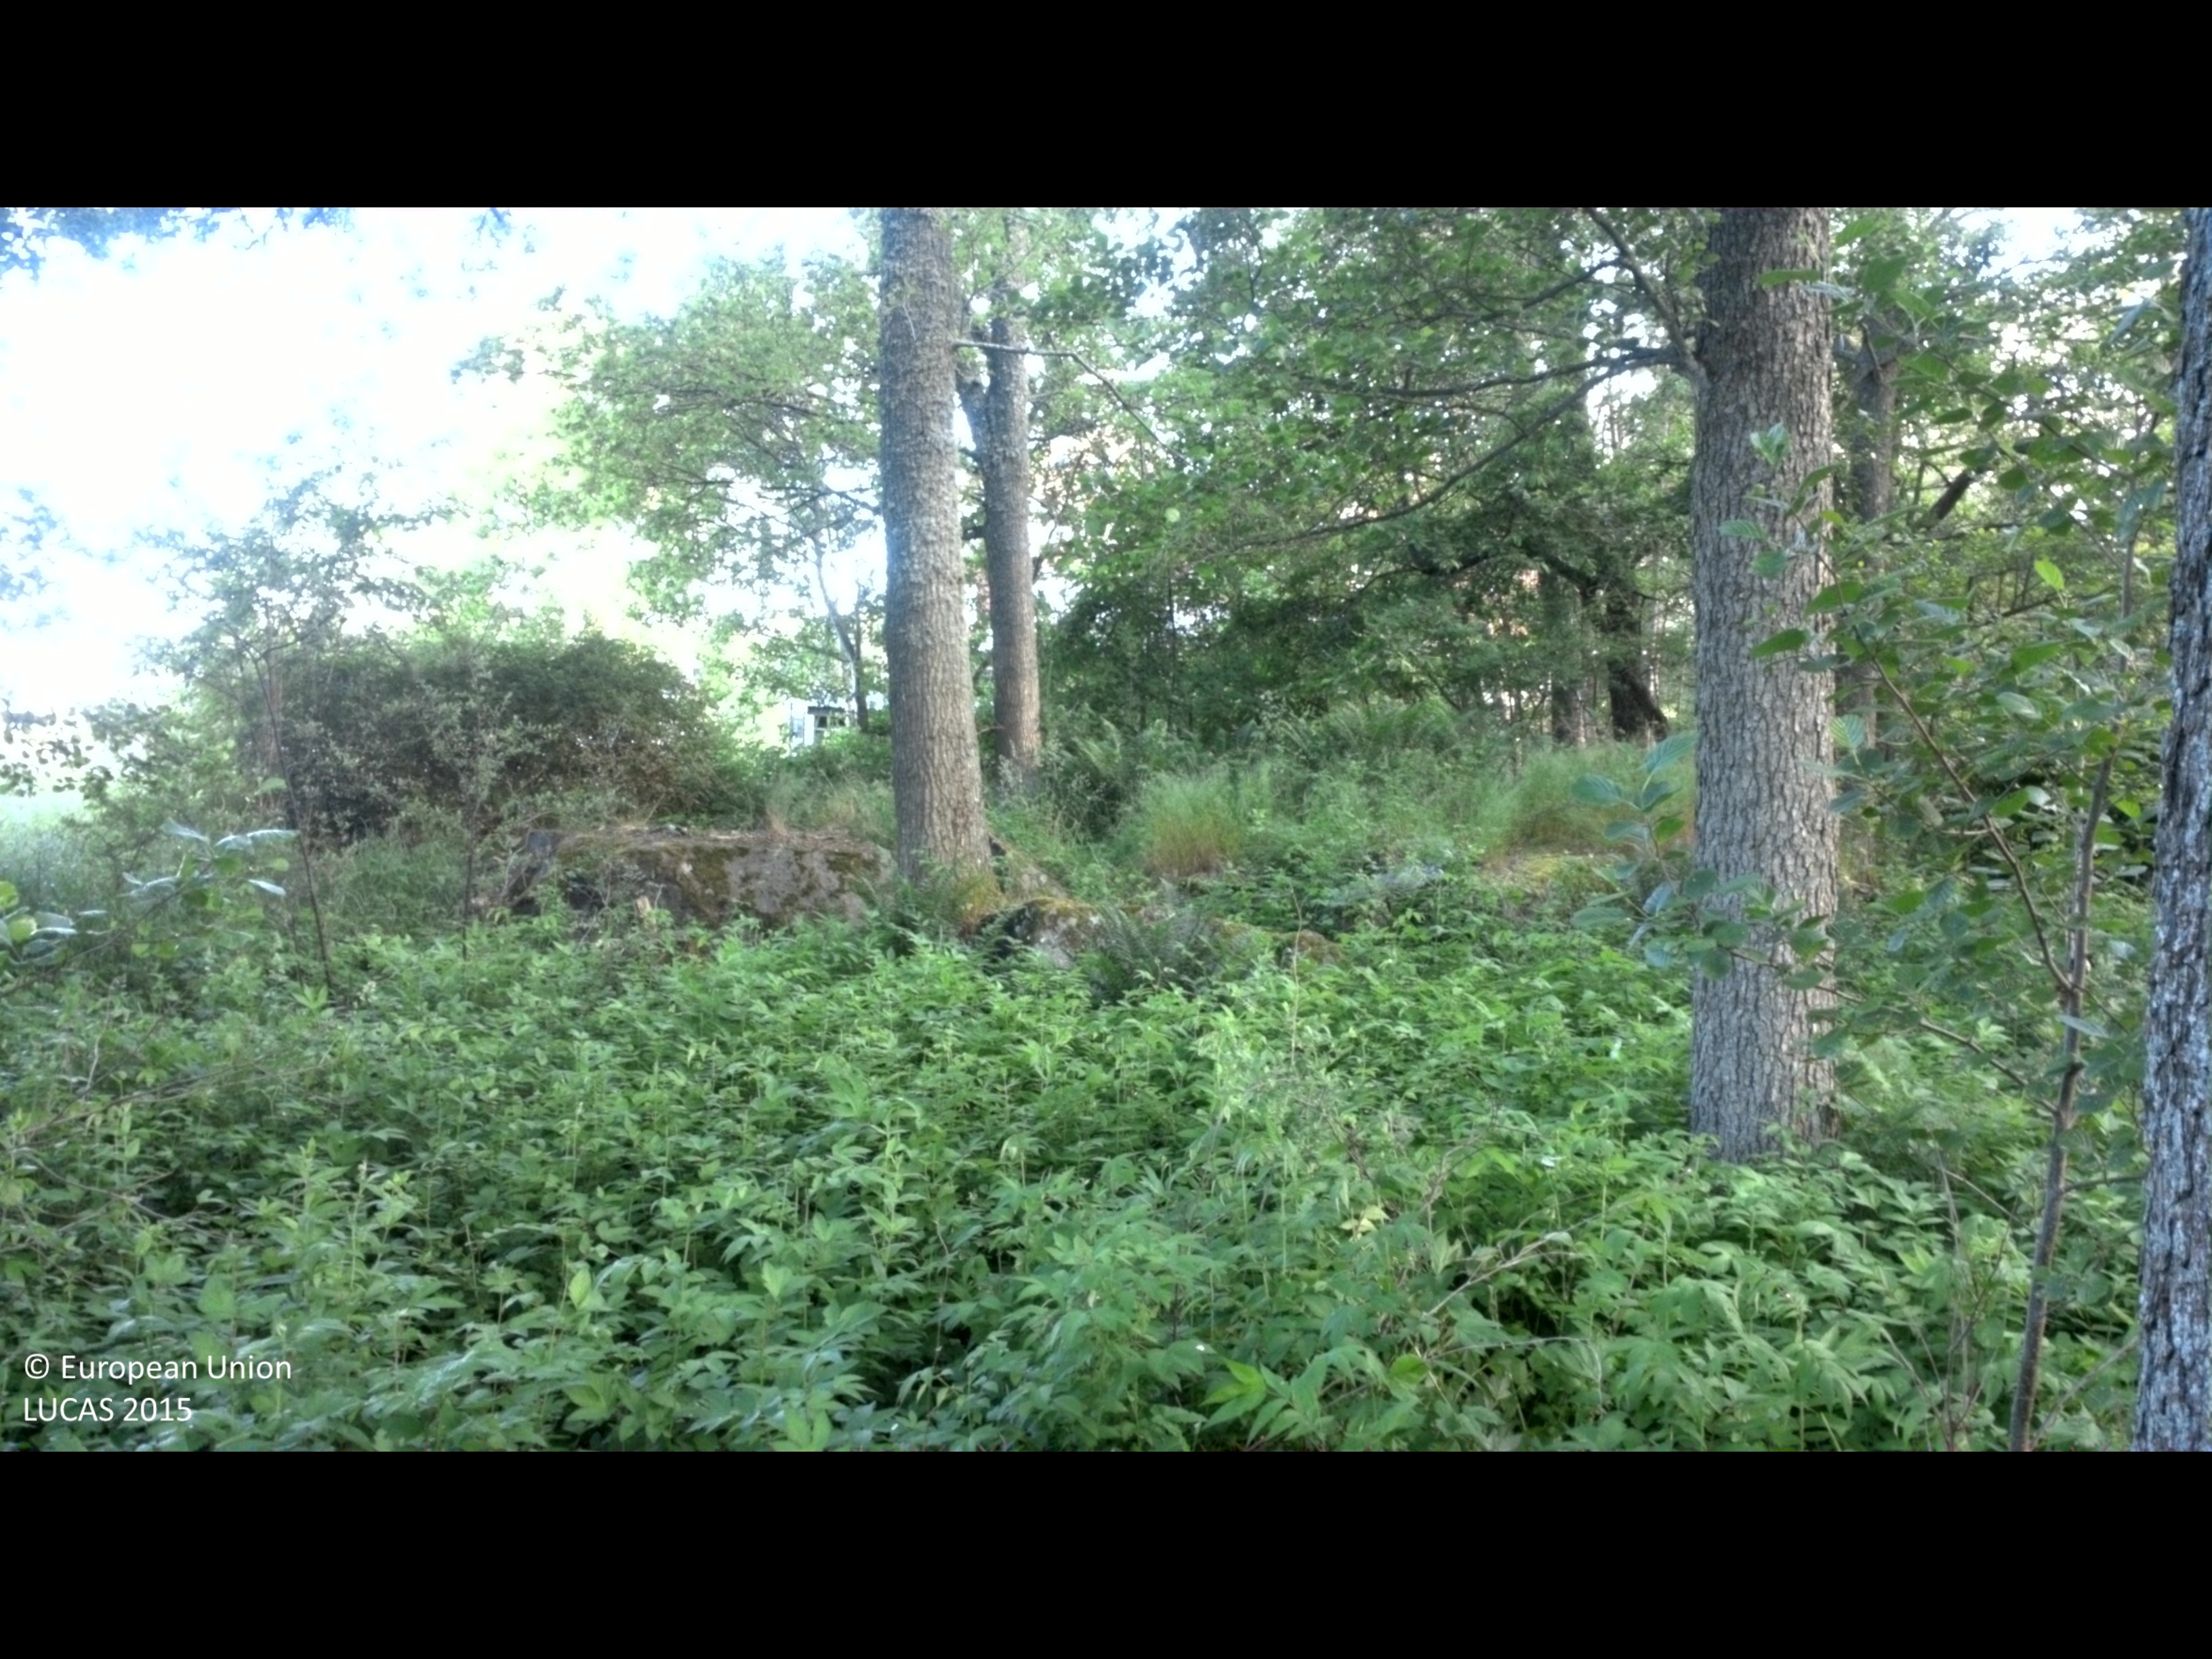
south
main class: Woodland
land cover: Broadleaved woodland
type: hemiboreal forest and nemoral coniferous forest and mixed broadleaved-coniferous forest
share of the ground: > 75 %
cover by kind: broadleaved forest trees 75 %, herbaceous plants 20 %, shrubs 5 %
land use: Forestry
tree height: > 5 m
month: June
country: SE
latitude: 57.7649
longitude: 16.6722
